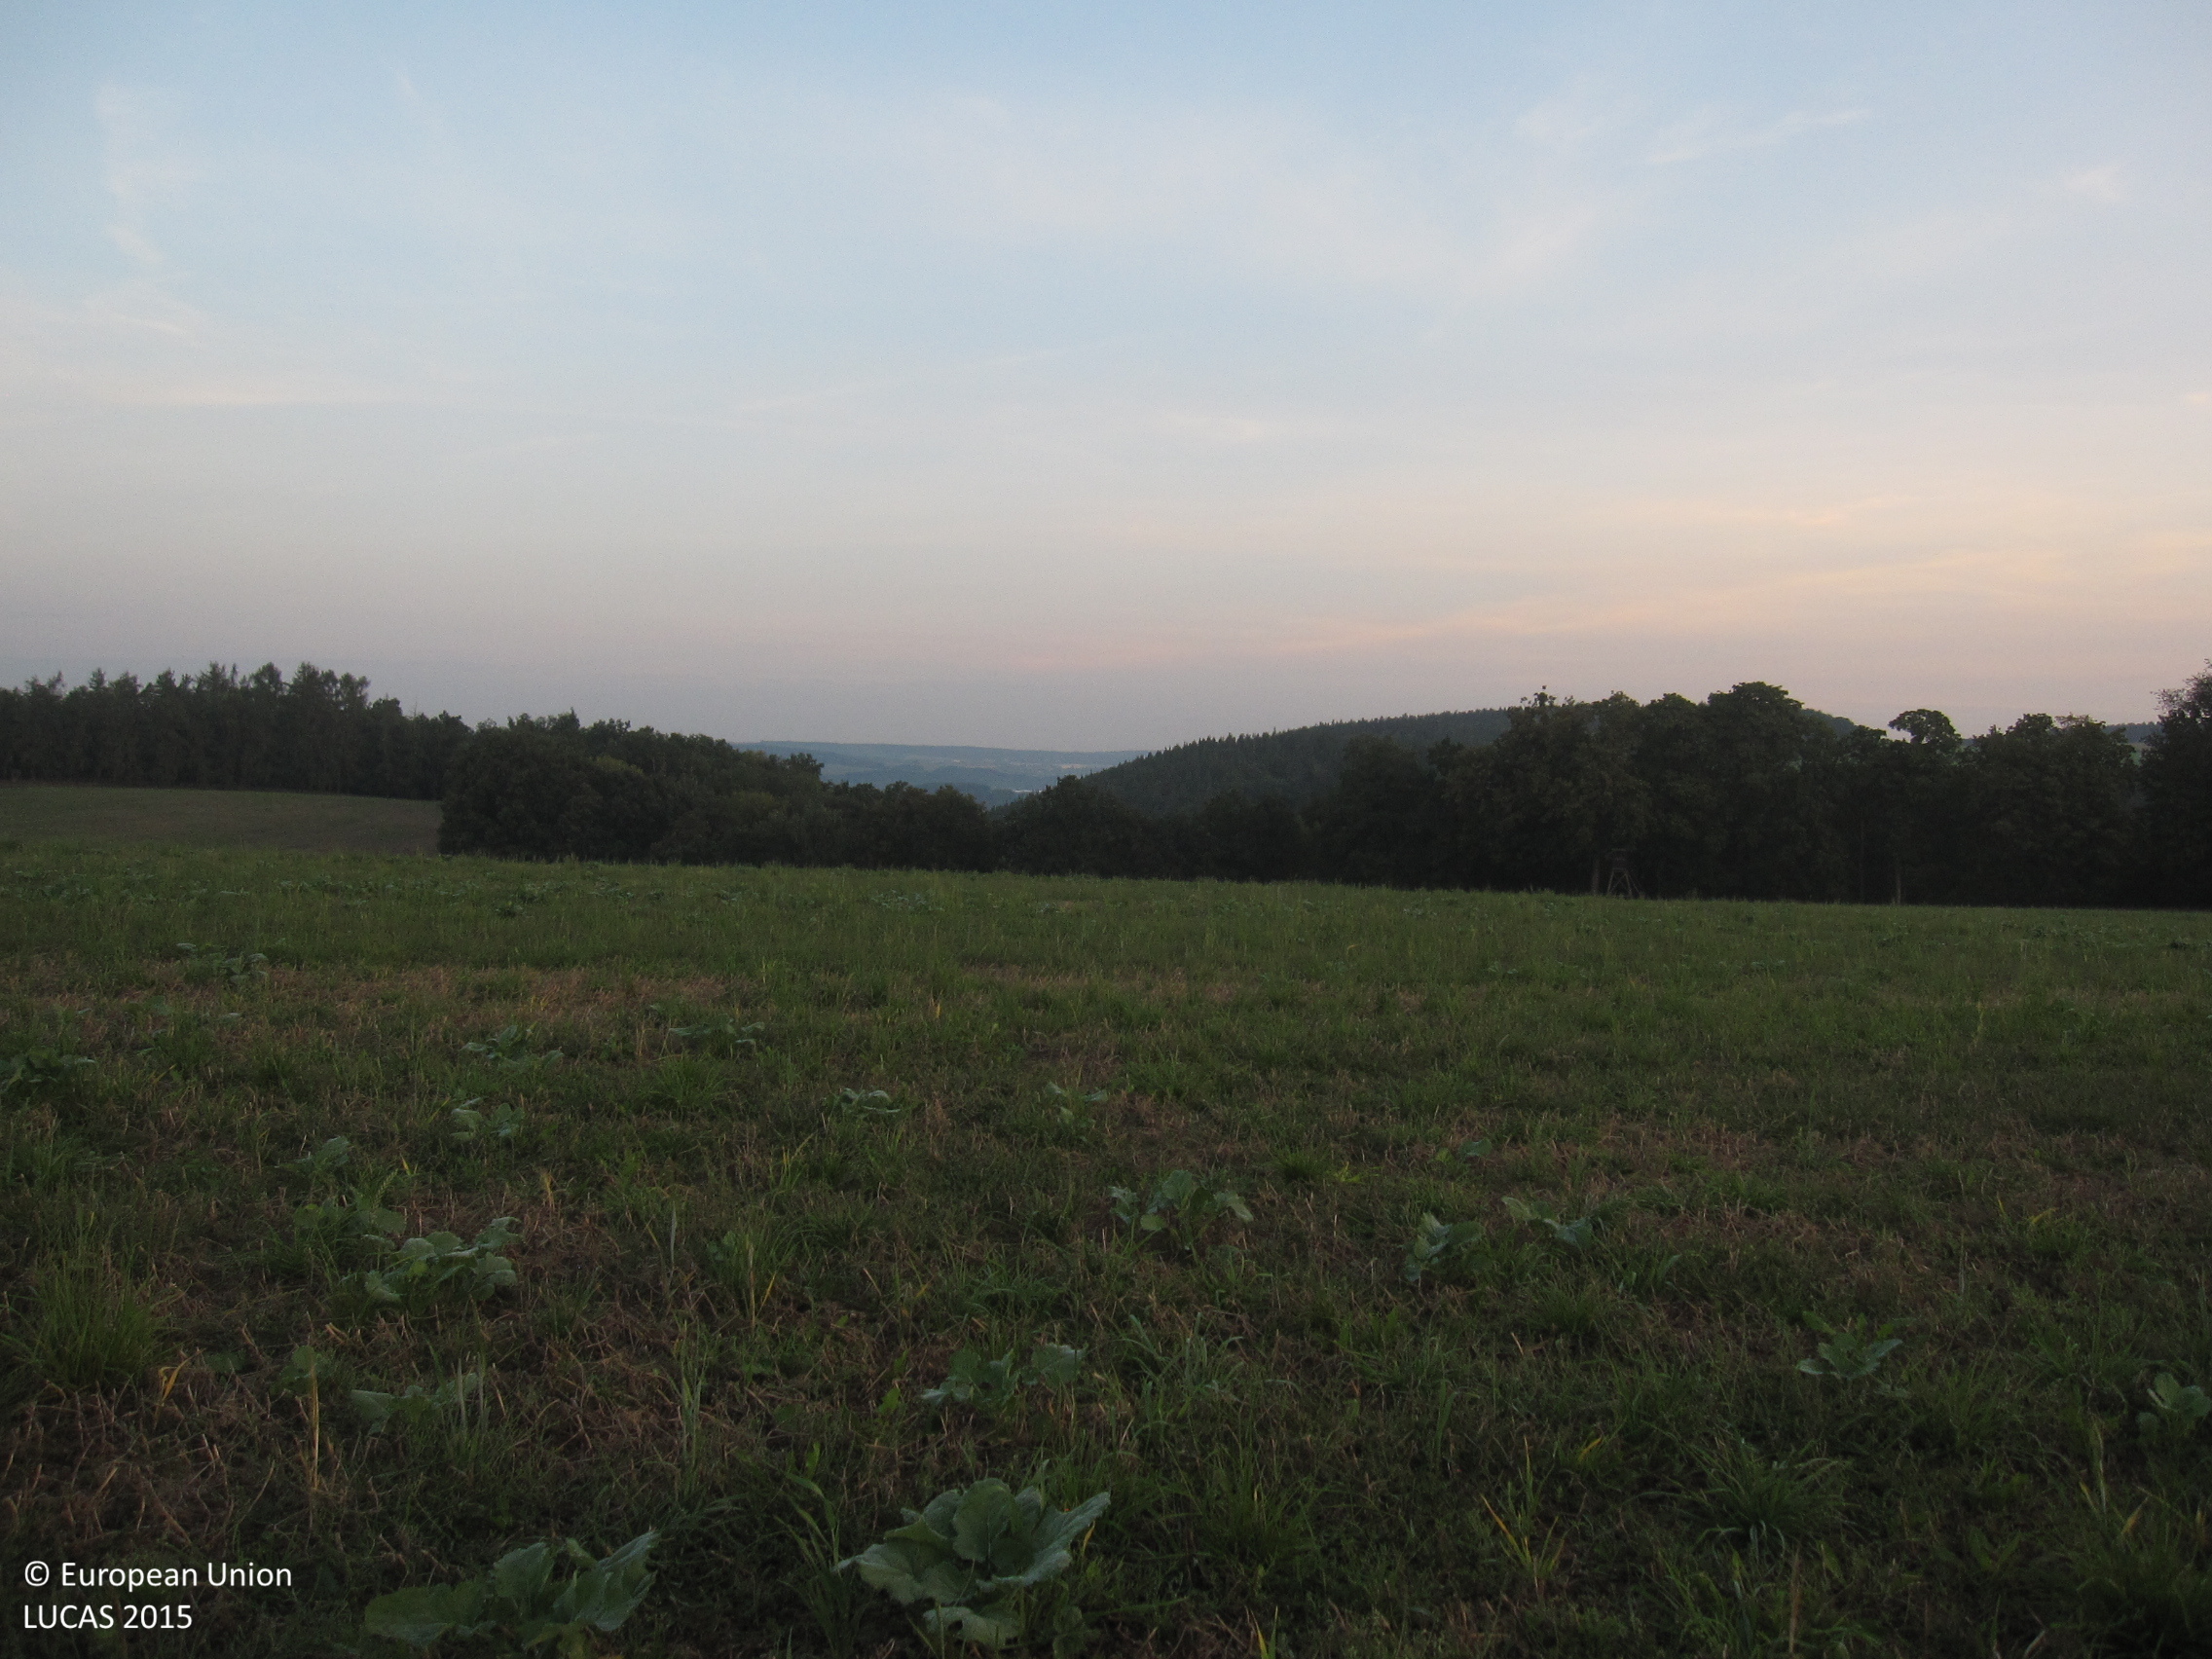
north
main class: Grassland
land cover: Grassland without tree/shrub cover
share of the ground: > 75 %
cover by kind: herbaceous plants 80 %, unconsolidated bare surface 20 %
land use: Agriculture (excluding fallow land and kitchen gardens)
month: August
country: DE
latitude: 50.7762
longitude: 12.1127
